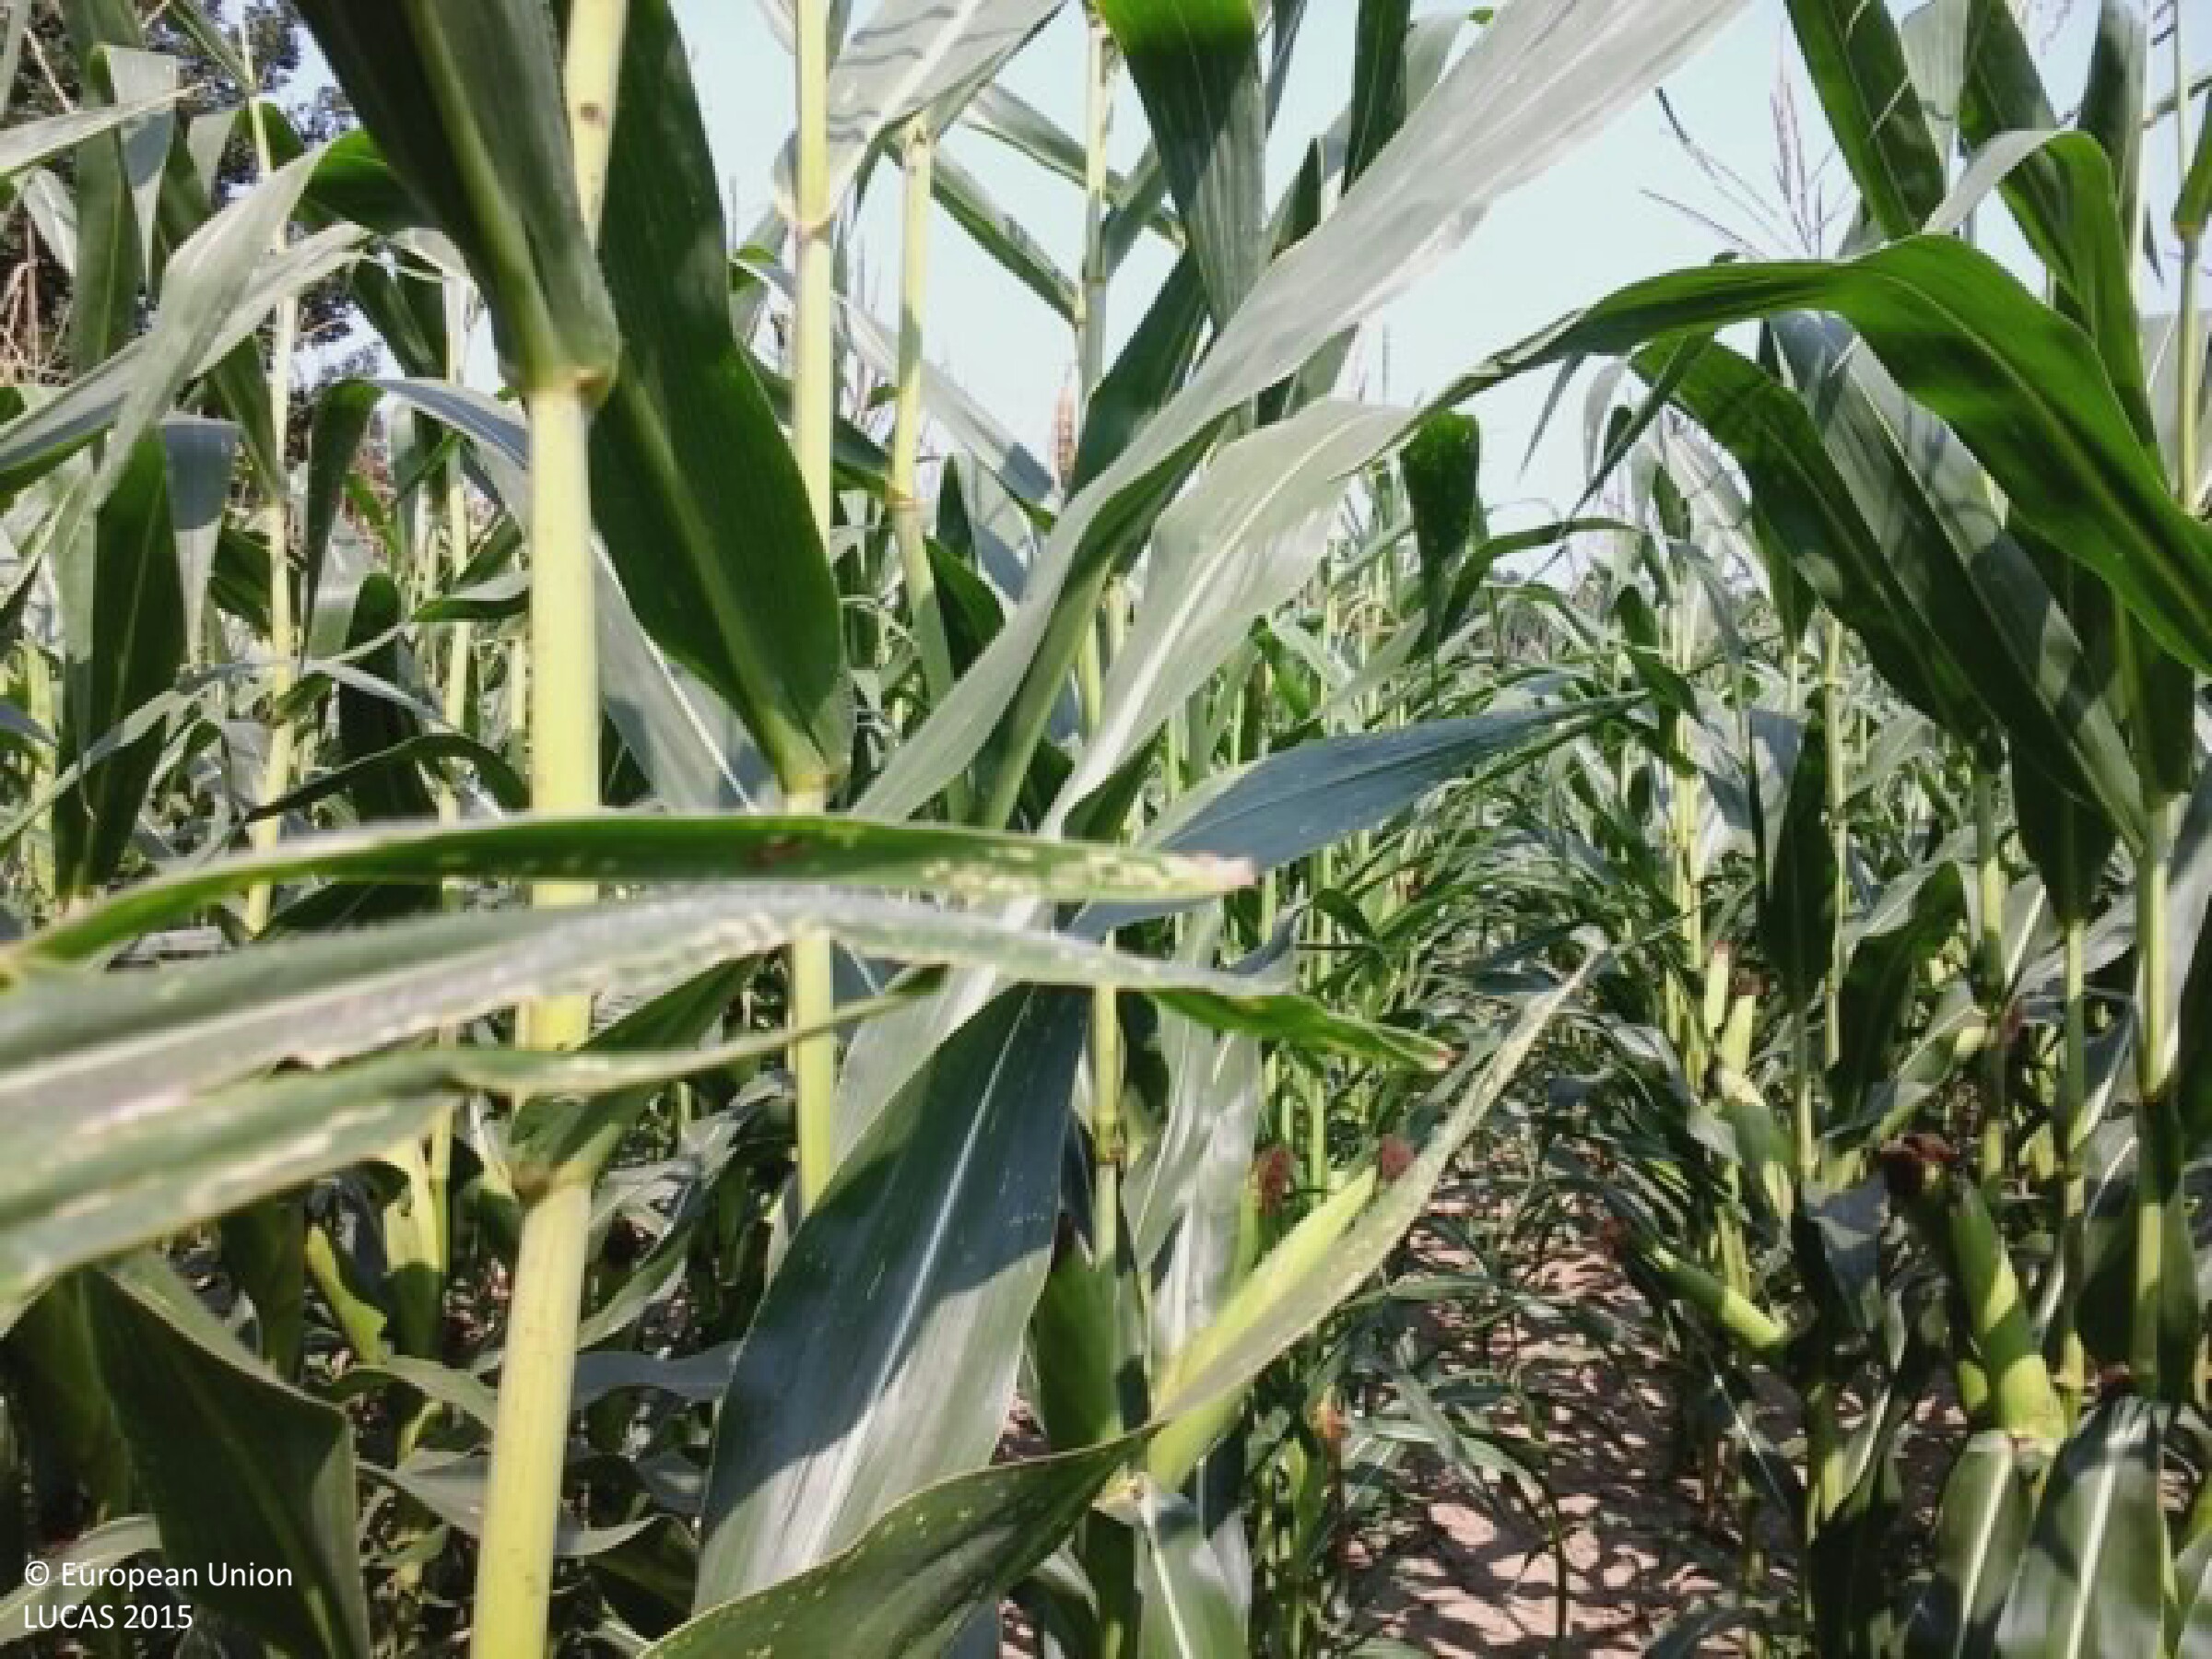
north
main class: Cropland
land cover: Maize
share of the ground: > 75 %
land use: Agriculture (excluding fallow land and kitchen gardens)
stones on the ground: < 10 %
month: August
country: HU
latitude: 46.1830
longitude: 17.1668
